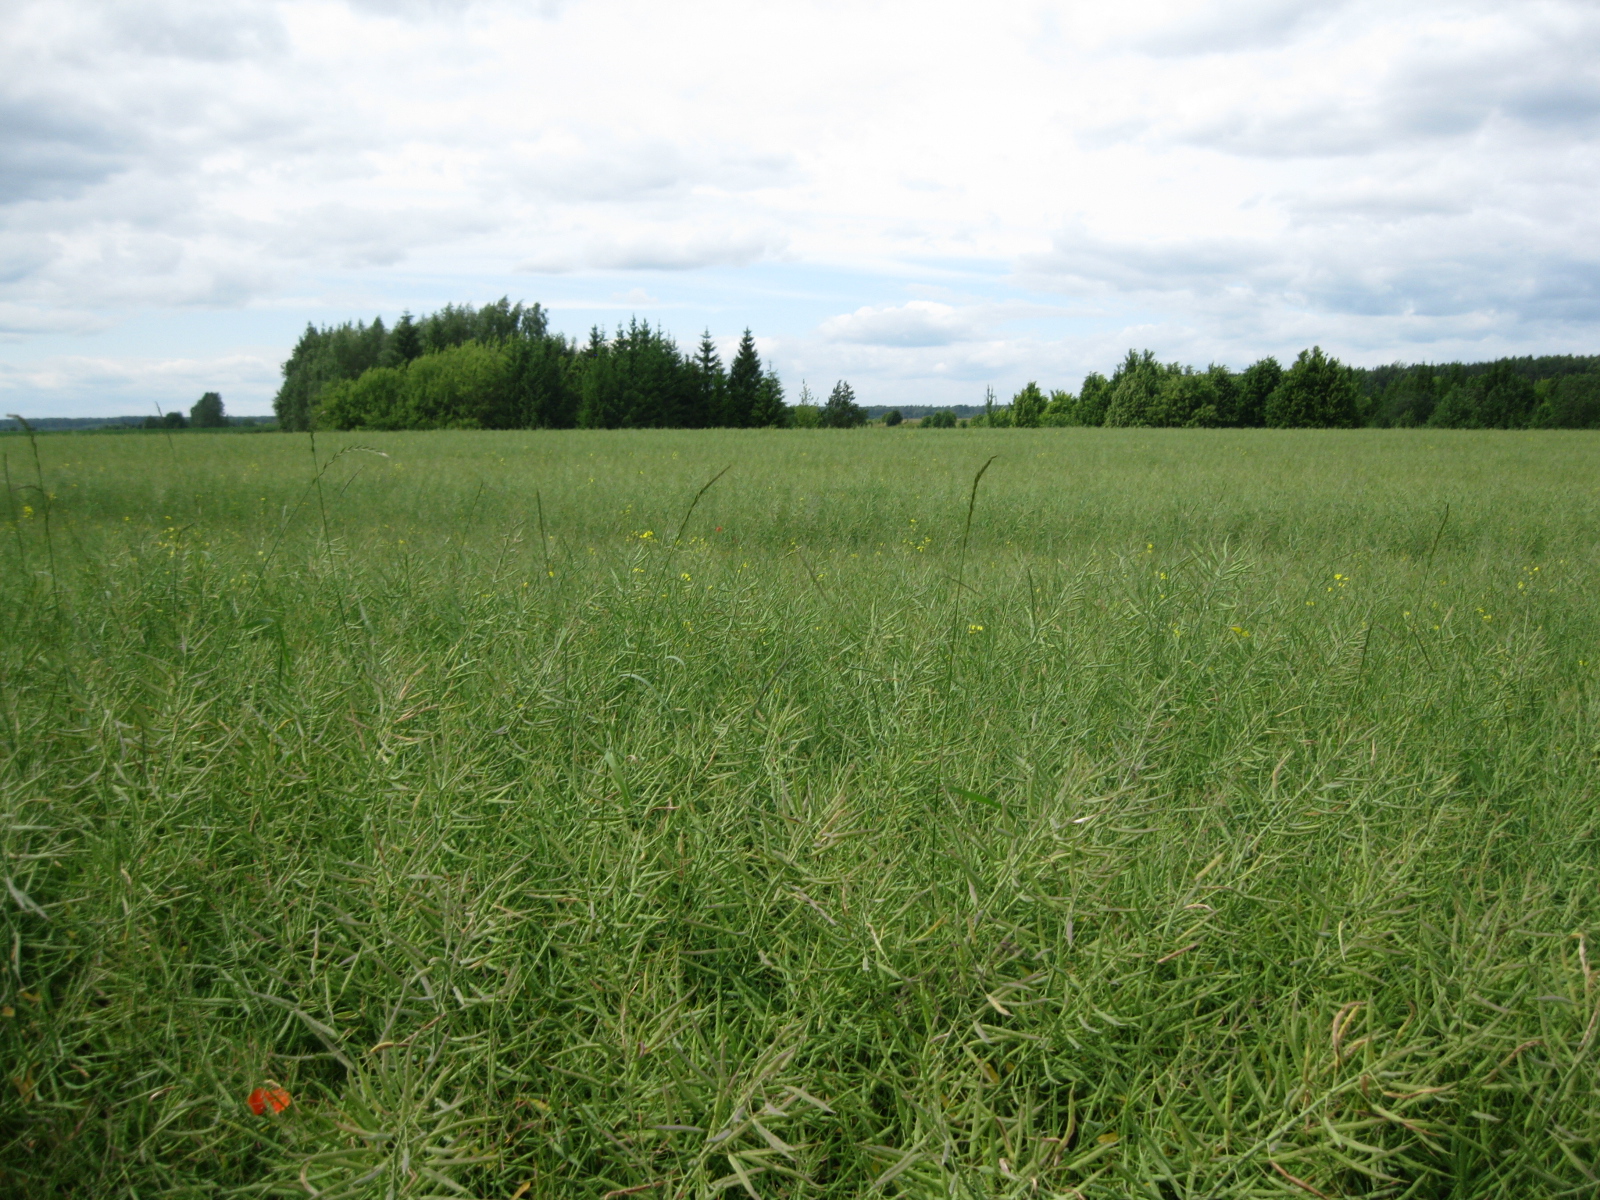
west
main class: Cropland
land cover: Rape and turnip rape
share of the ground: > 75 %
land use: Agriculture (excluding fallow land and kitchen gardens)
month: June
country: LT
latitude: 55.6076
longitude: 24.2377
